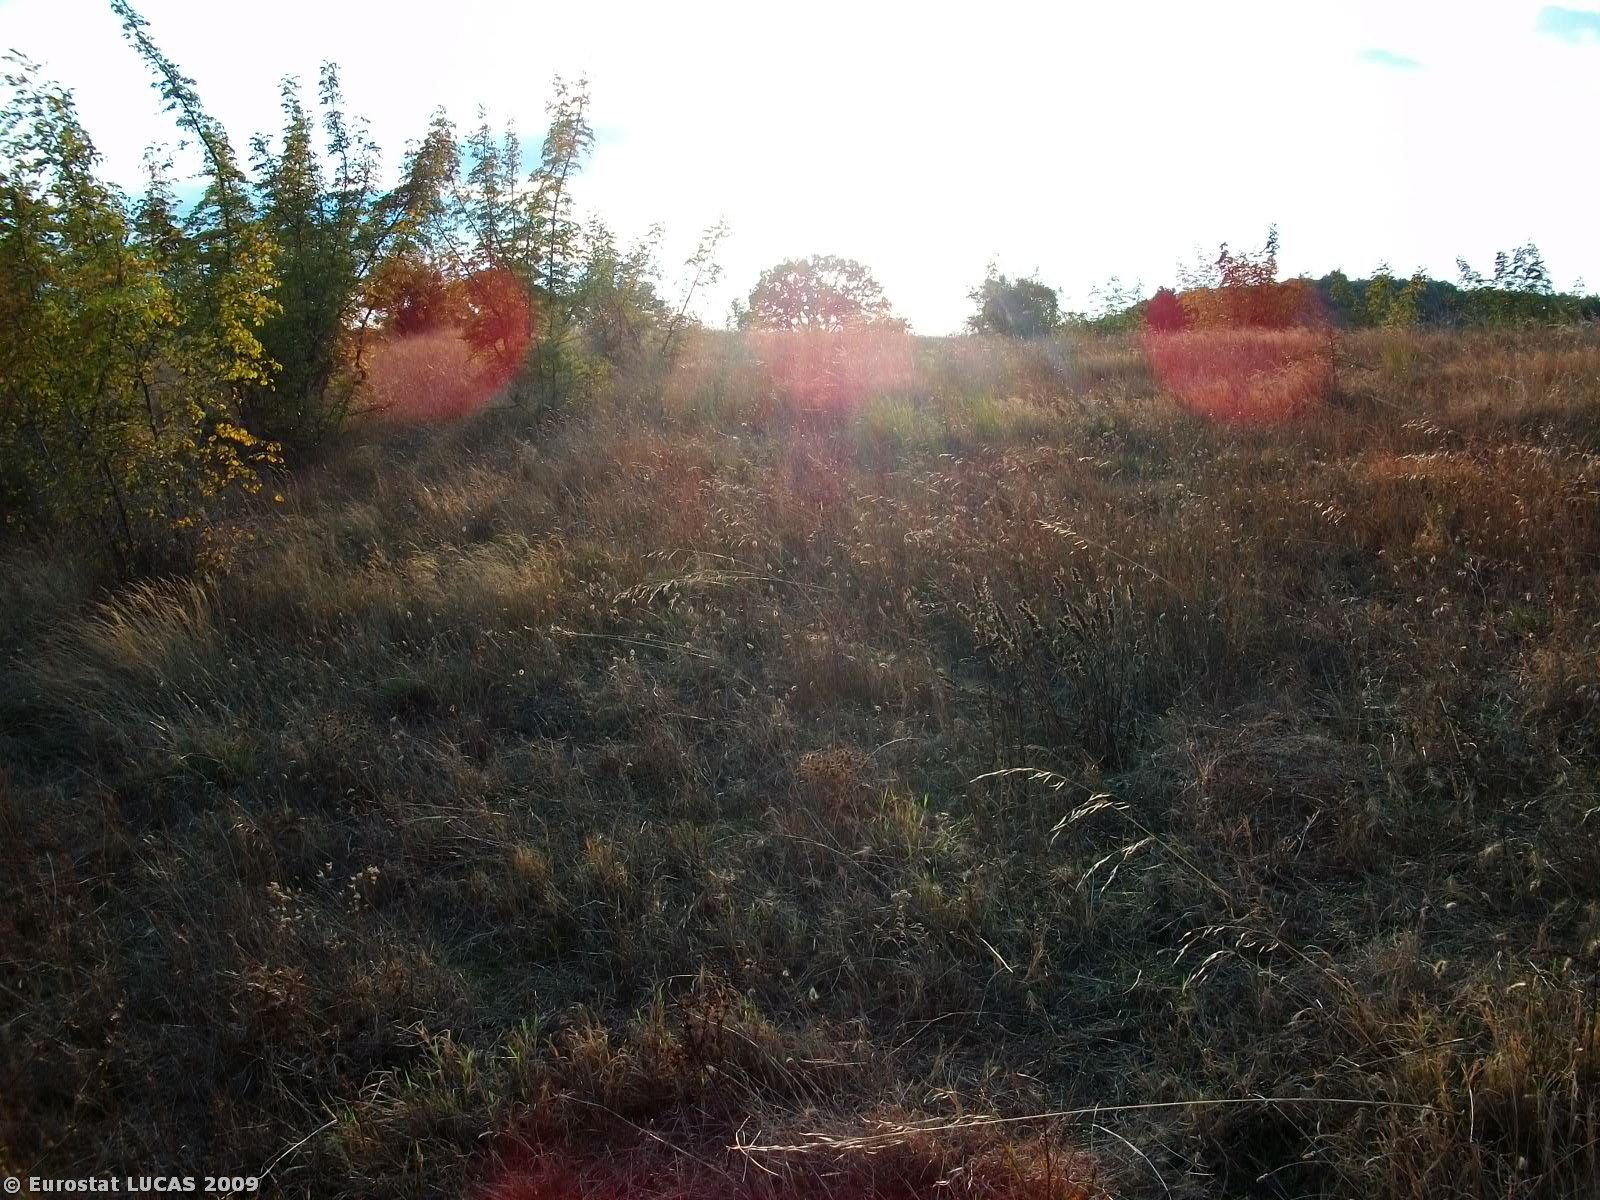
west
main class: Shrubland
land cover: Shrubland without tree cover
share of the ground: 50 - 75 %
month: September
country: GR
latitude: 41.2339
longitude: 26.2840
